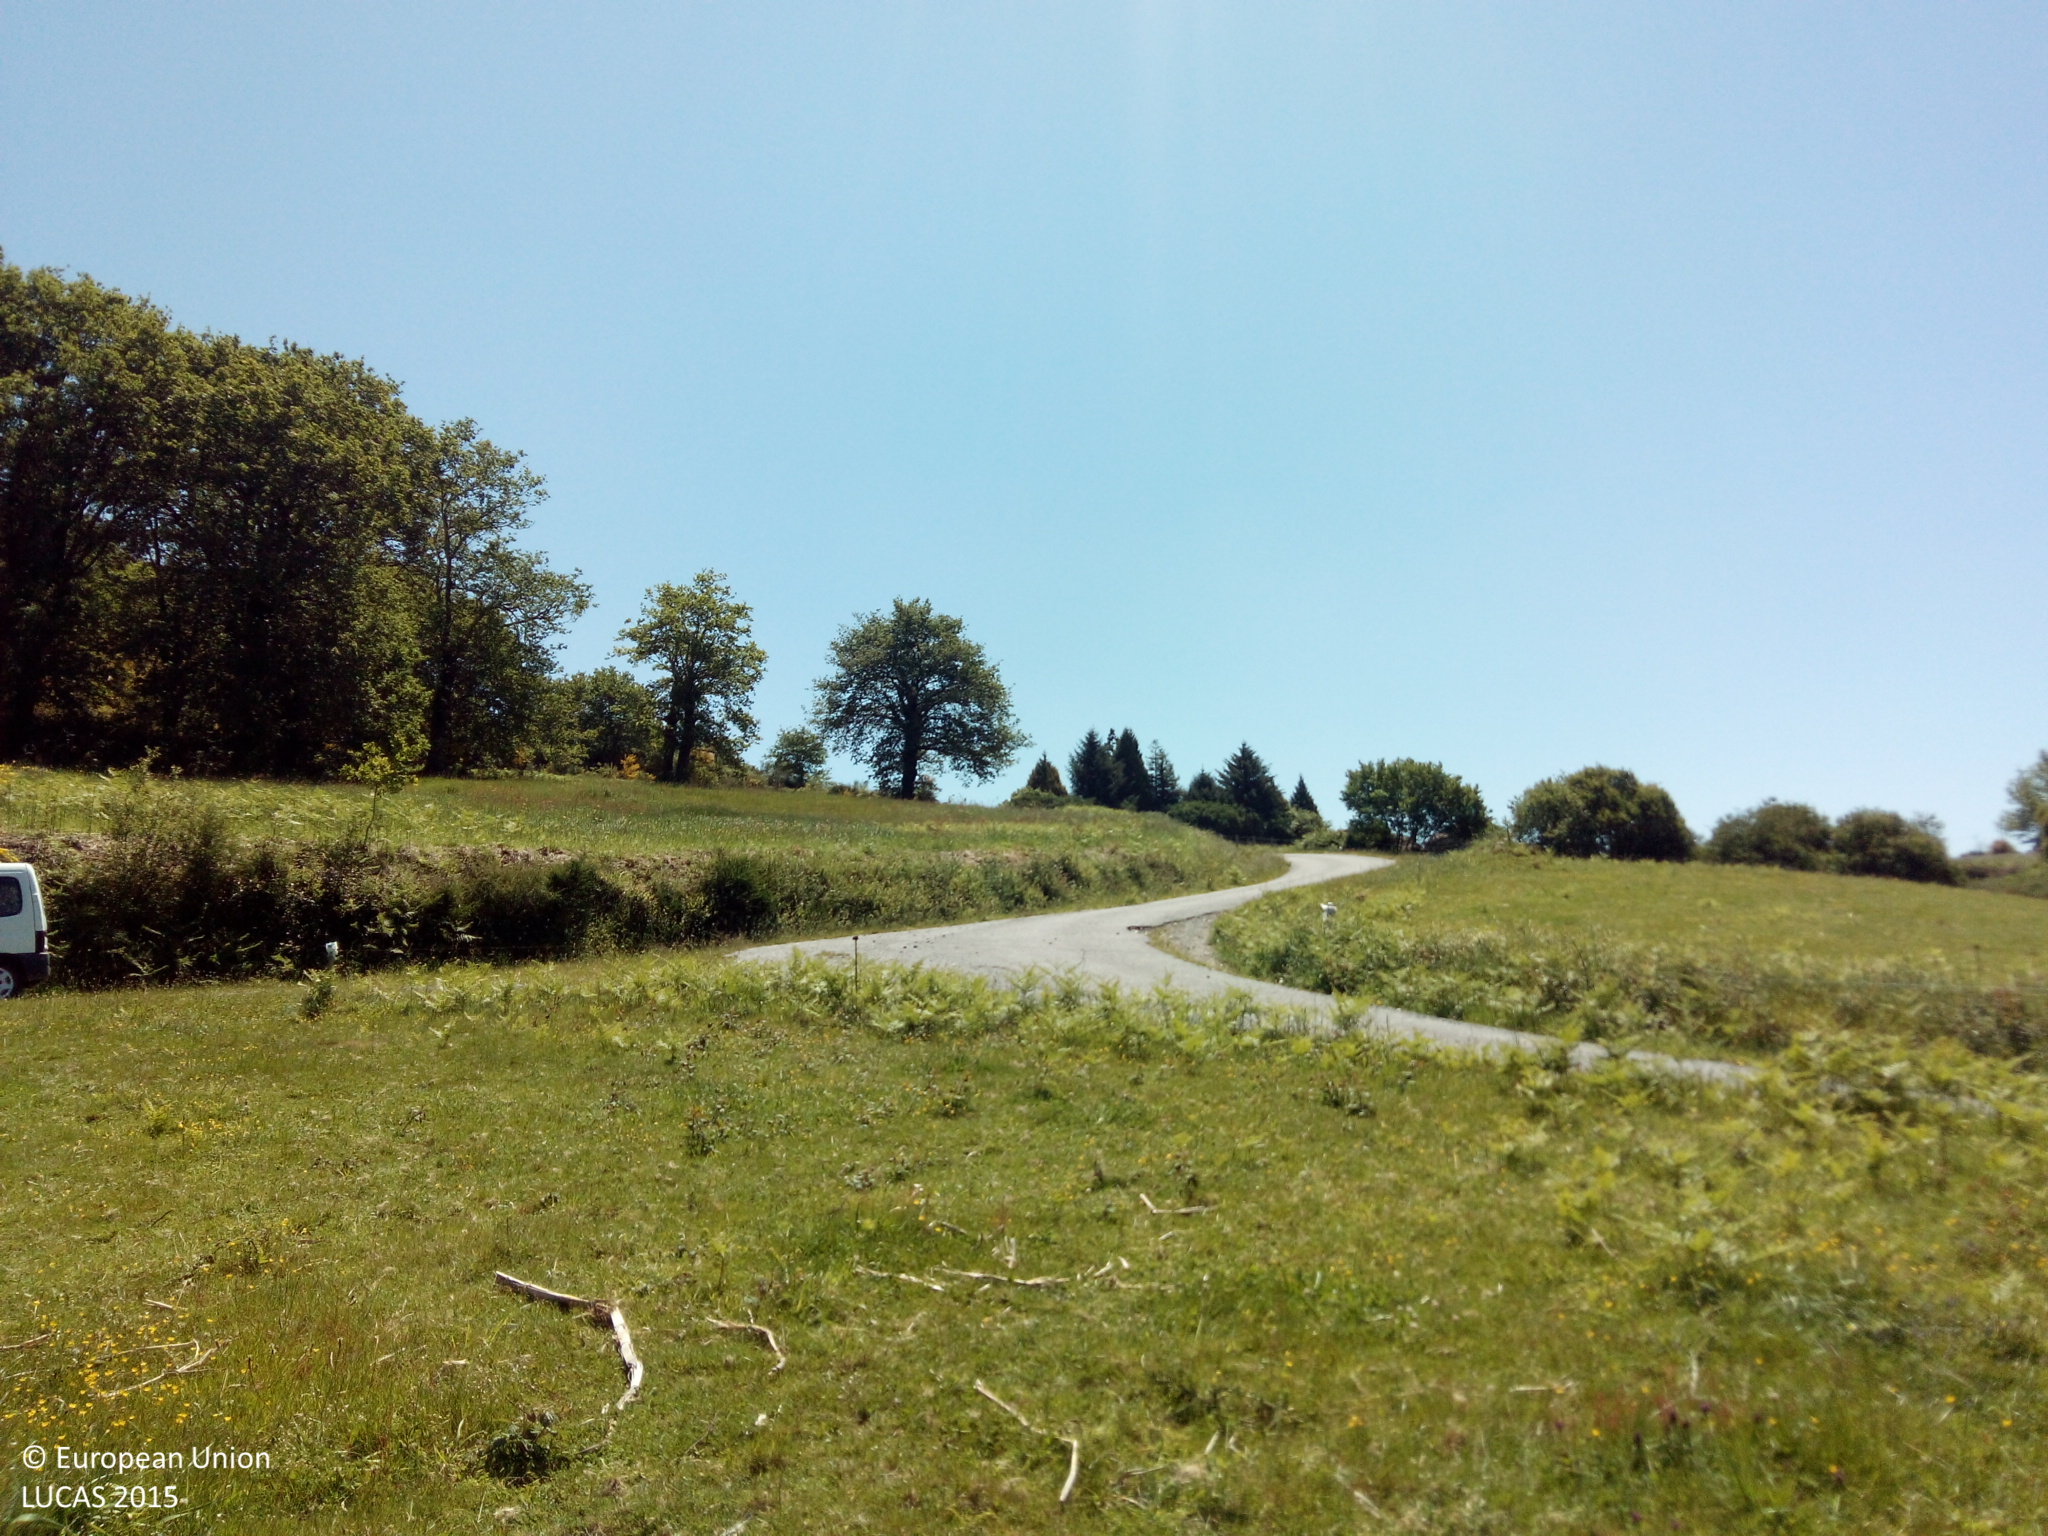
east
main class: Grassland
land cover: Grassland without tree/shrub cover
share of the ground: > 75 %
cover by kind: herbaceous plants 100 %
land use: Agriculture (excluding fallow land and kitchen gardens)
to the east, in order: Grassland without tree/shrub cover; Grass margins; Tracks; Artificial constructions; Broadleaved woodland; Fences; Shrubland with sparse tree cover; Grass margins; Tracks; Grass margins; Ditches and canals; Broadleaved woodland
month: May
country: ES
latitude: 42.6451
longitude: -8.4298
